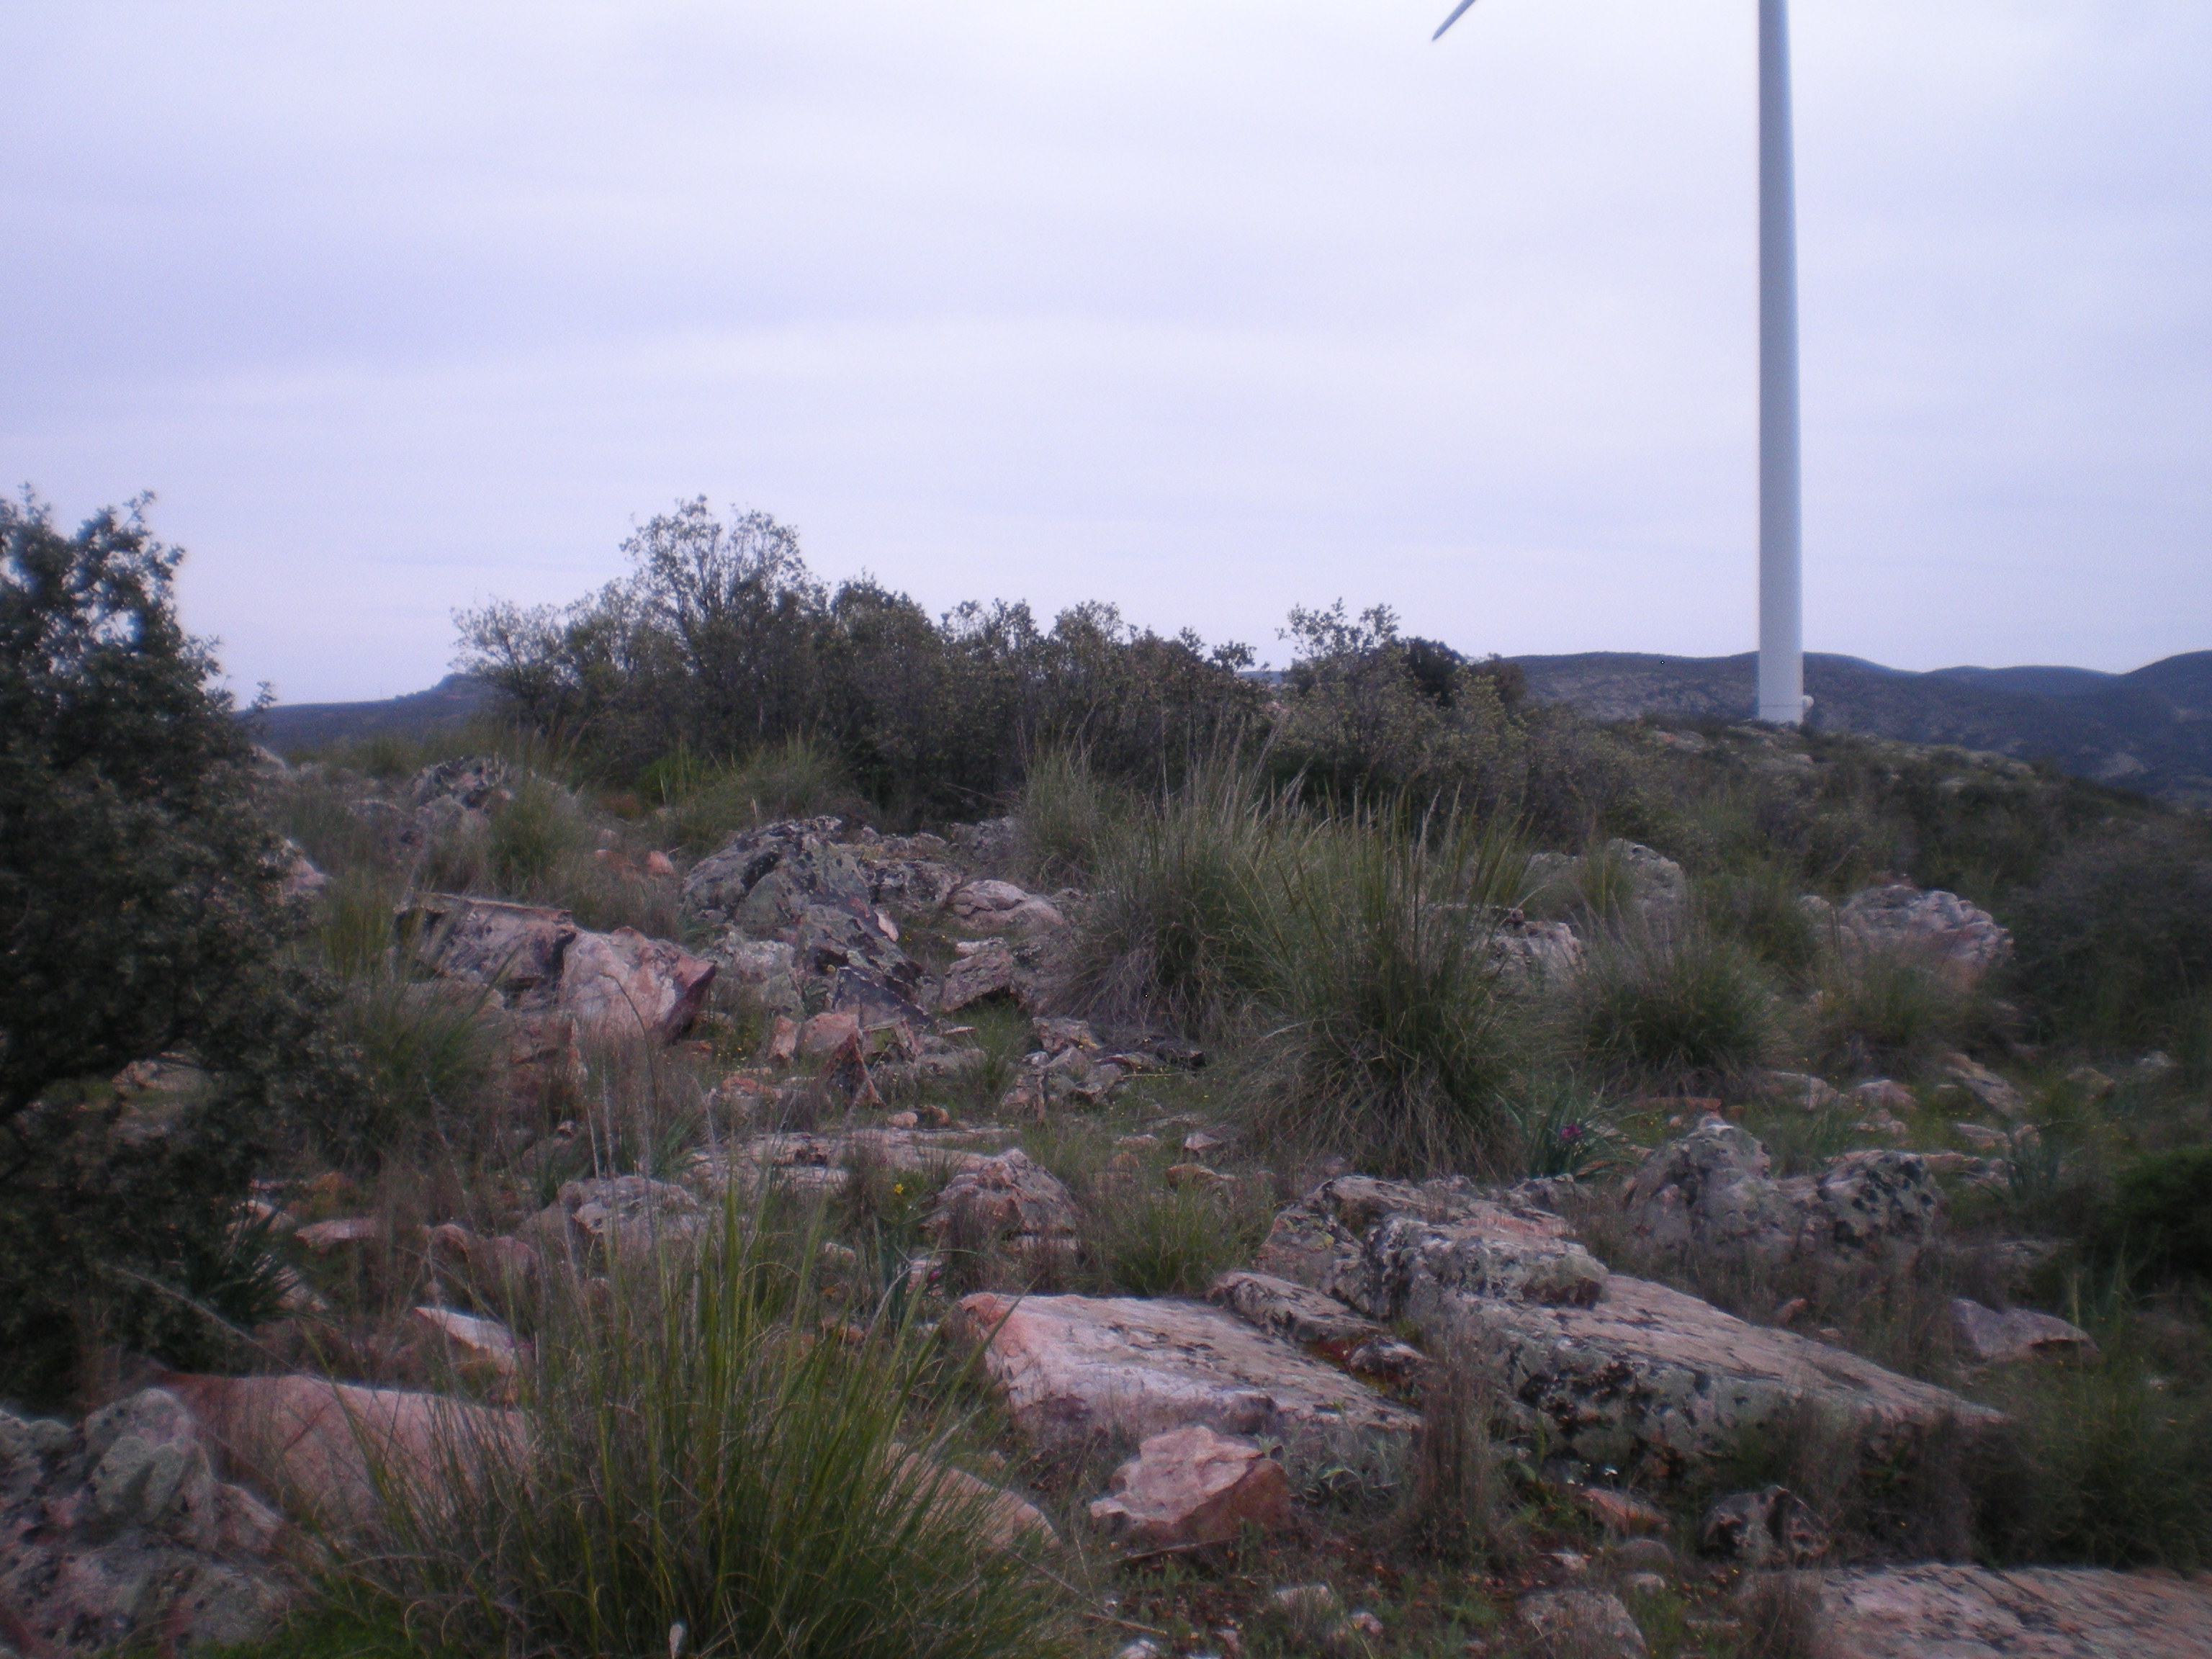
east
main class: Shrubland
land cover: Shrubland without tree cover
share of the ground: 10 - 25 %
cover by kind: herbaceous plants 50 %, consolidated bare surface 40 %, shrubs 10 %
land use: Semi-natural and natural areas not in use
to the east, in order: Shrubland without tree cover; Rocks and stones; Tracks; Shrubland without tree cover; Tracks
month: April
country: ES
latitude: 38.8425
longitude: -3.5747
